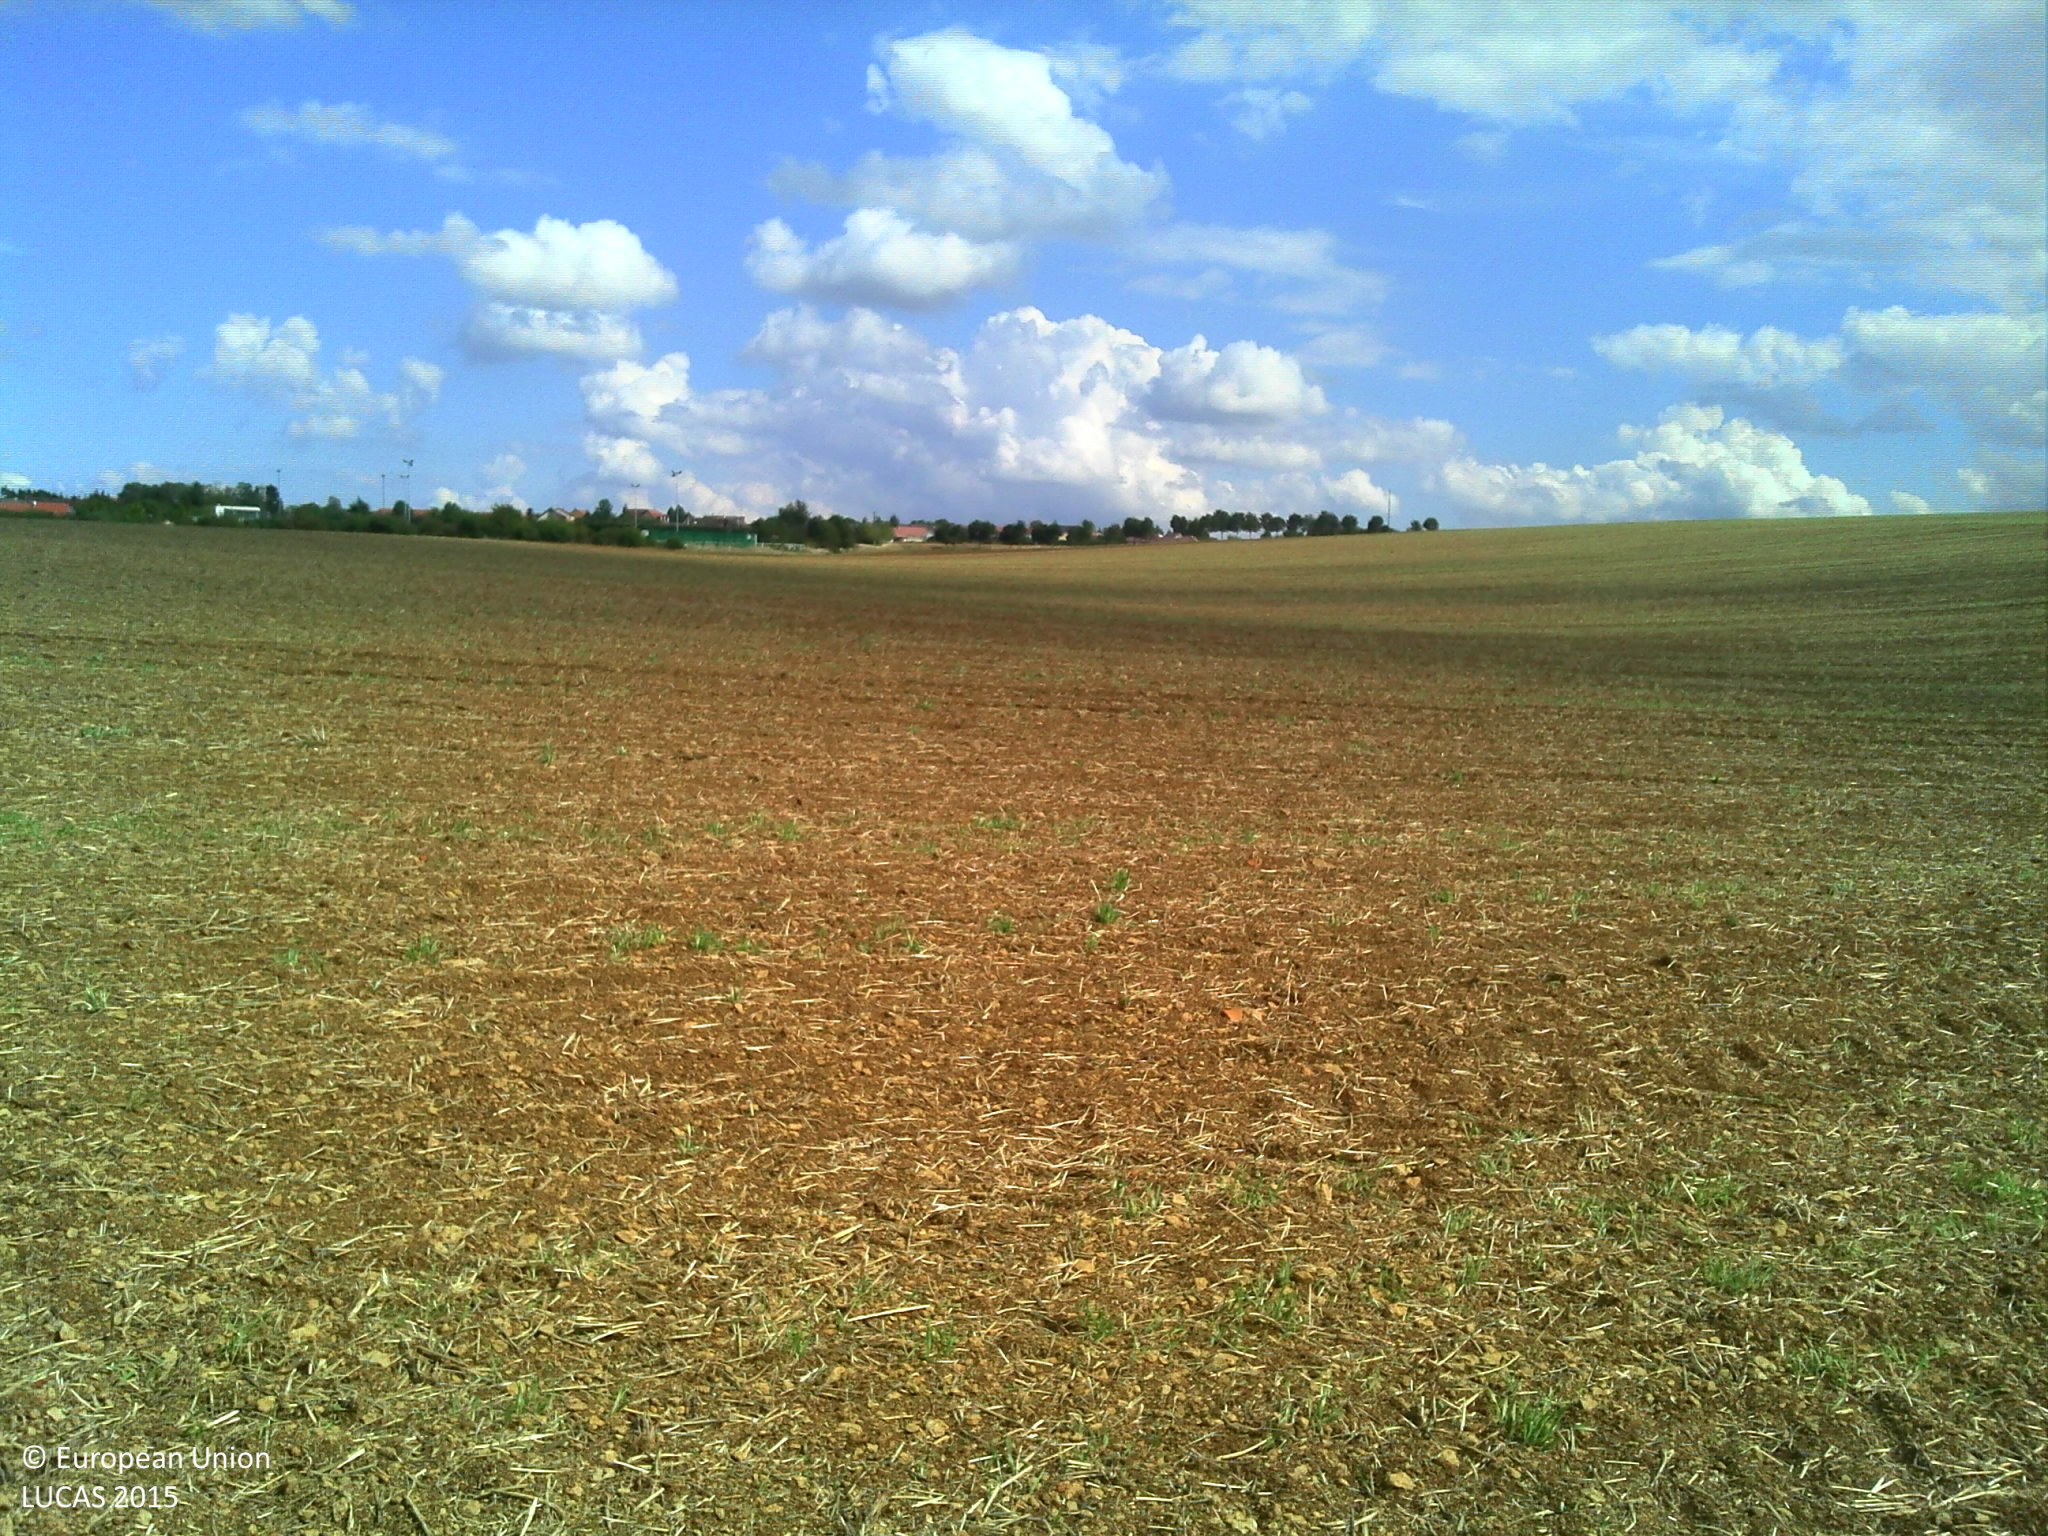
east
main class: Cropland
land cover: Common wheat
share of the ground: < 10 %
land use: Agriculture (excluding fallow land and kitchen gardens)
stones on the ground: 10 - 25 %
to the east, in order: Common wheat
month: September
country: FR
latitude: 49.1392
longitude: 5.9284
